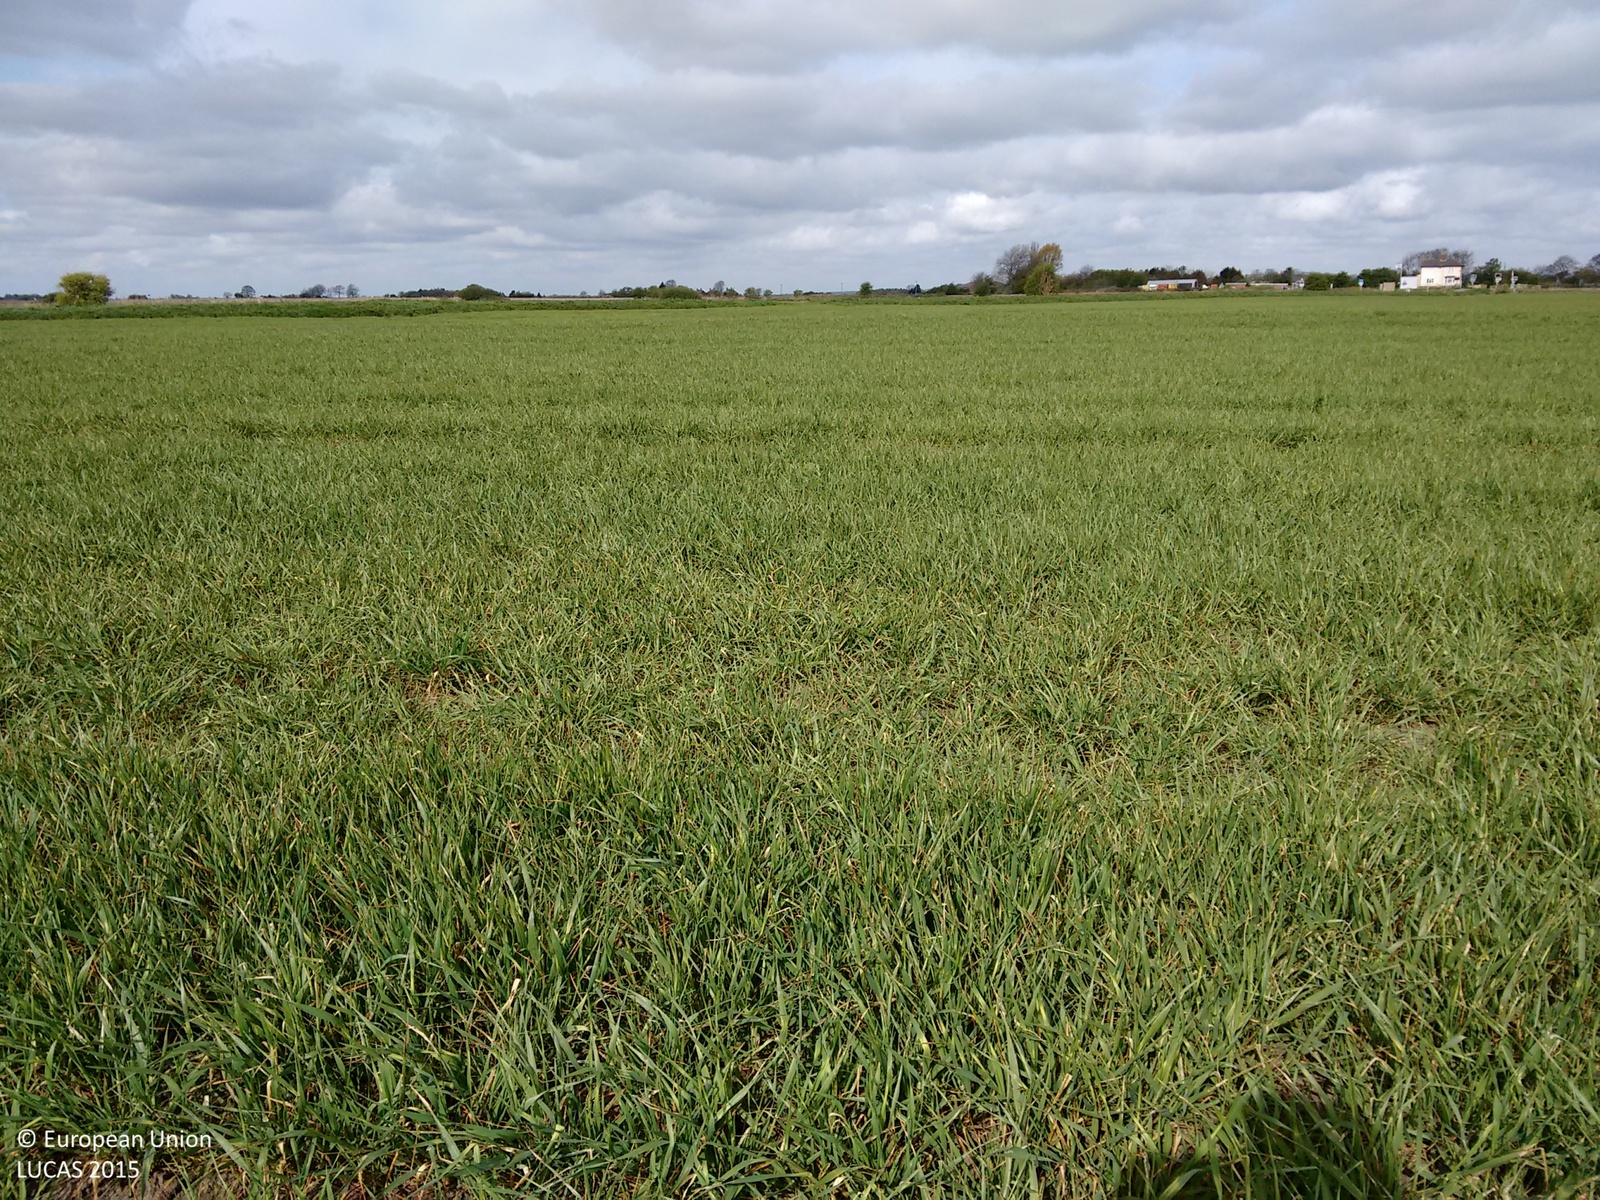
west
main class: Cropland
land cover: Barley
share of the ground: 50 - 75 %
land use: Agriculture (excluding fallow land and kitchen gardens)
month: May
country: GB
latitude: 53.1264
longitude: 0.1511
